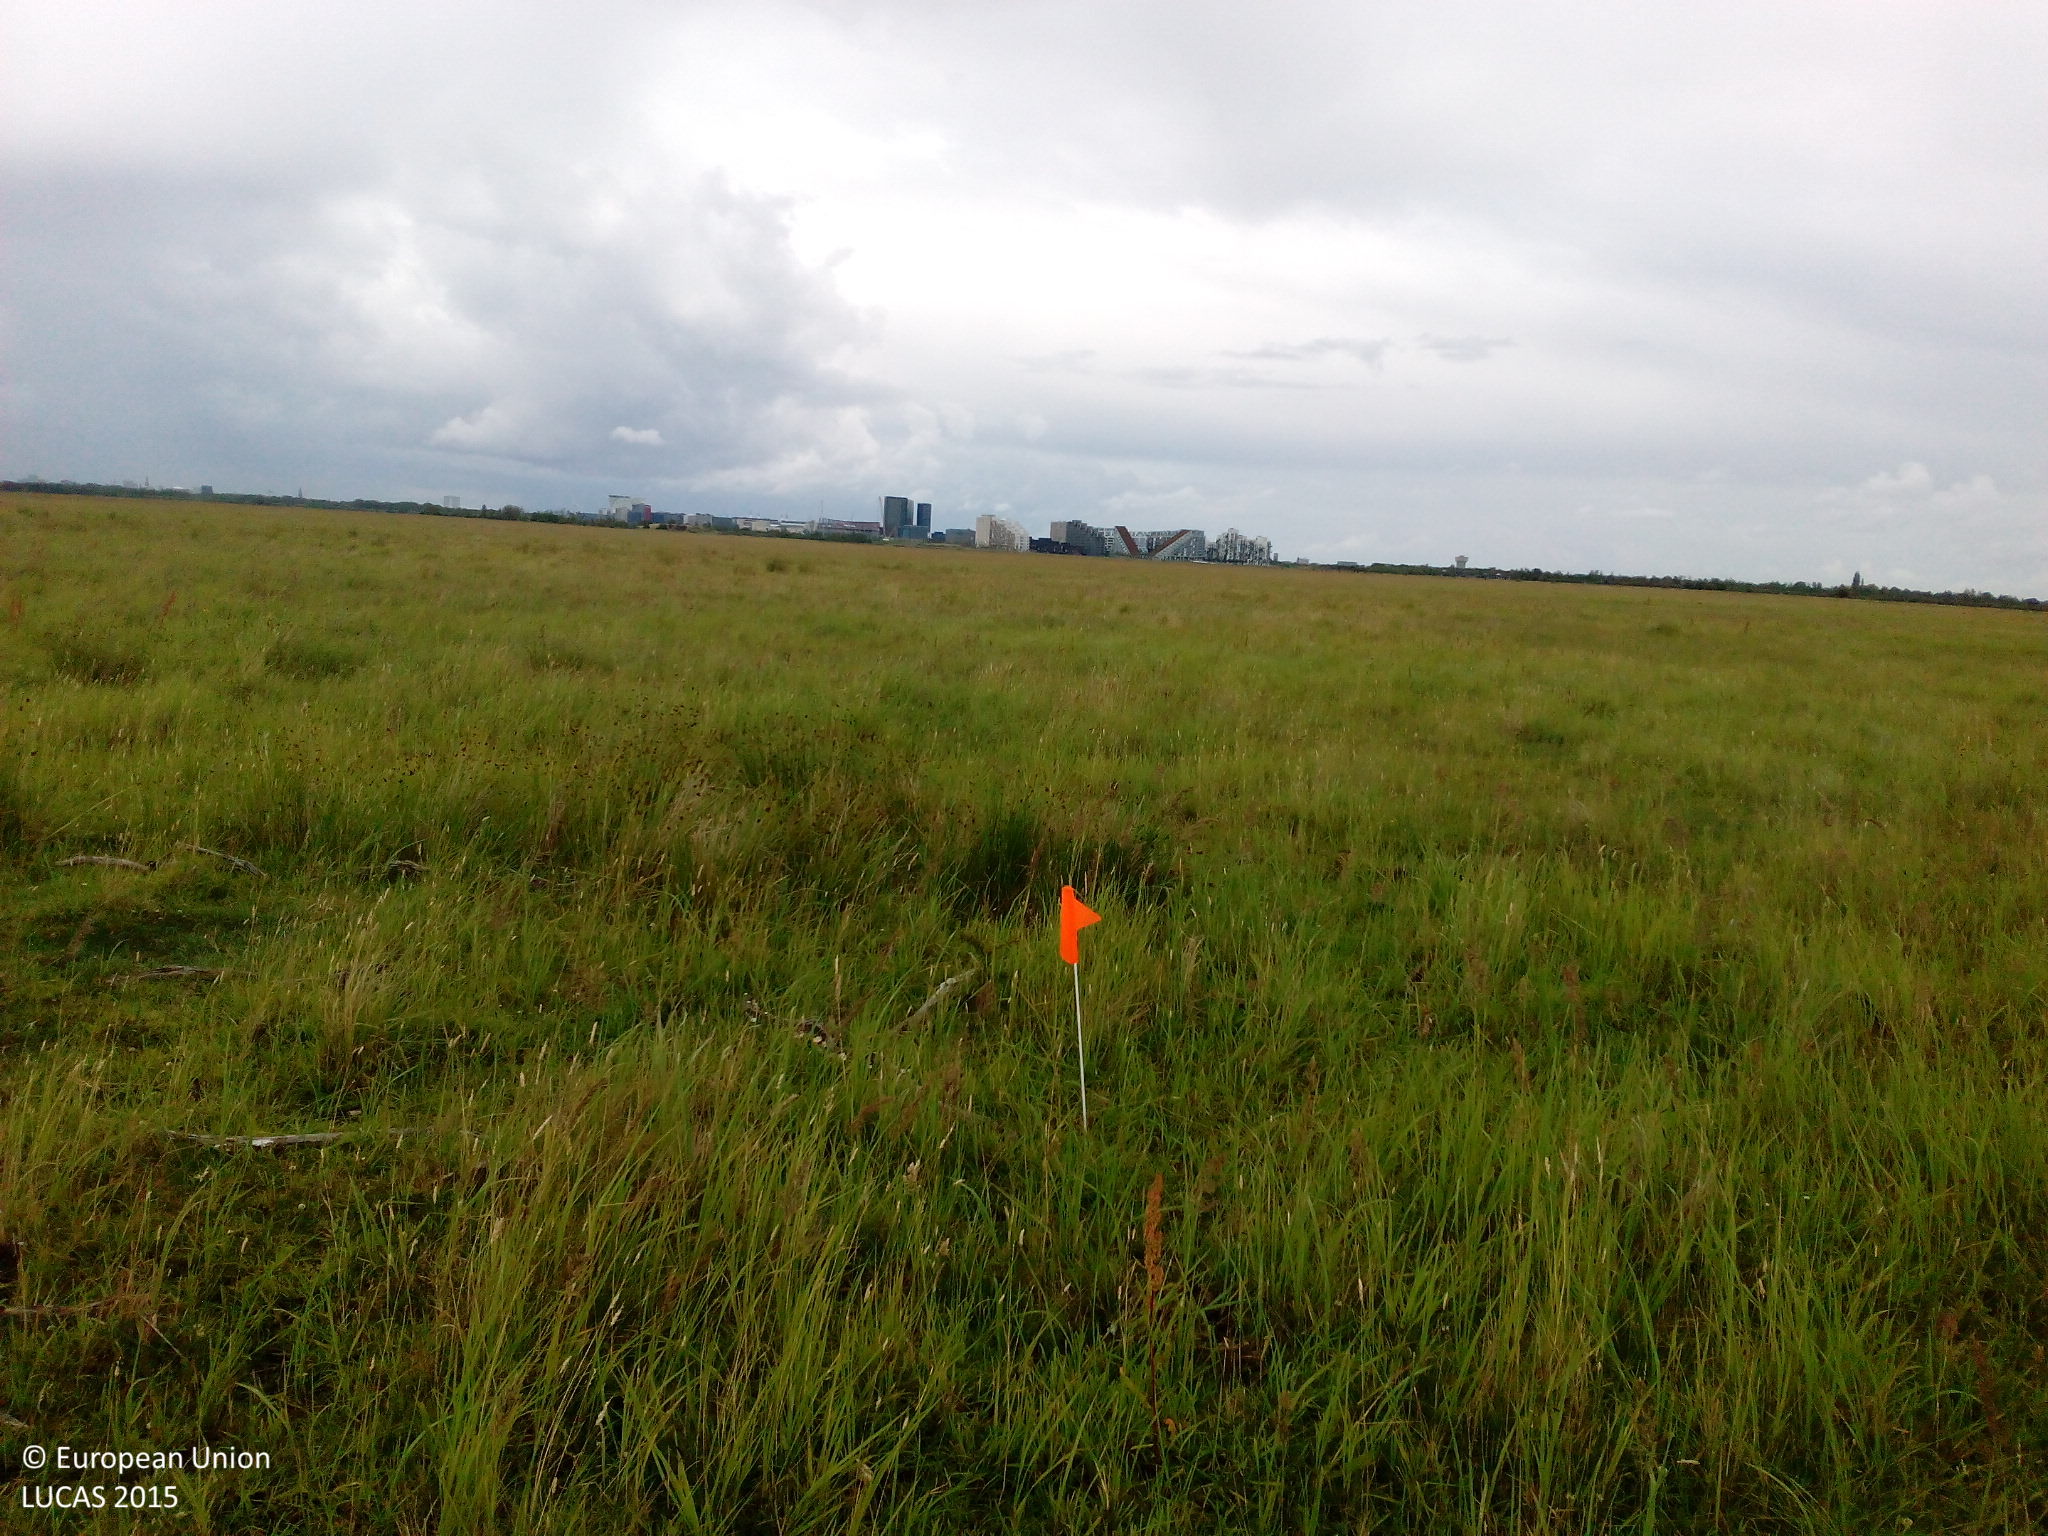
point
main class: Grassland
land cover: Grassland without tree/shrub cover
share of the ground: > 75 %
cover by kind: herbaceous plants 100 %
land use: Agriculture (excluding fallow land and kitchen gardens)
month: July
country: DK
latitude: 55.6048
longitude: 12.5536
